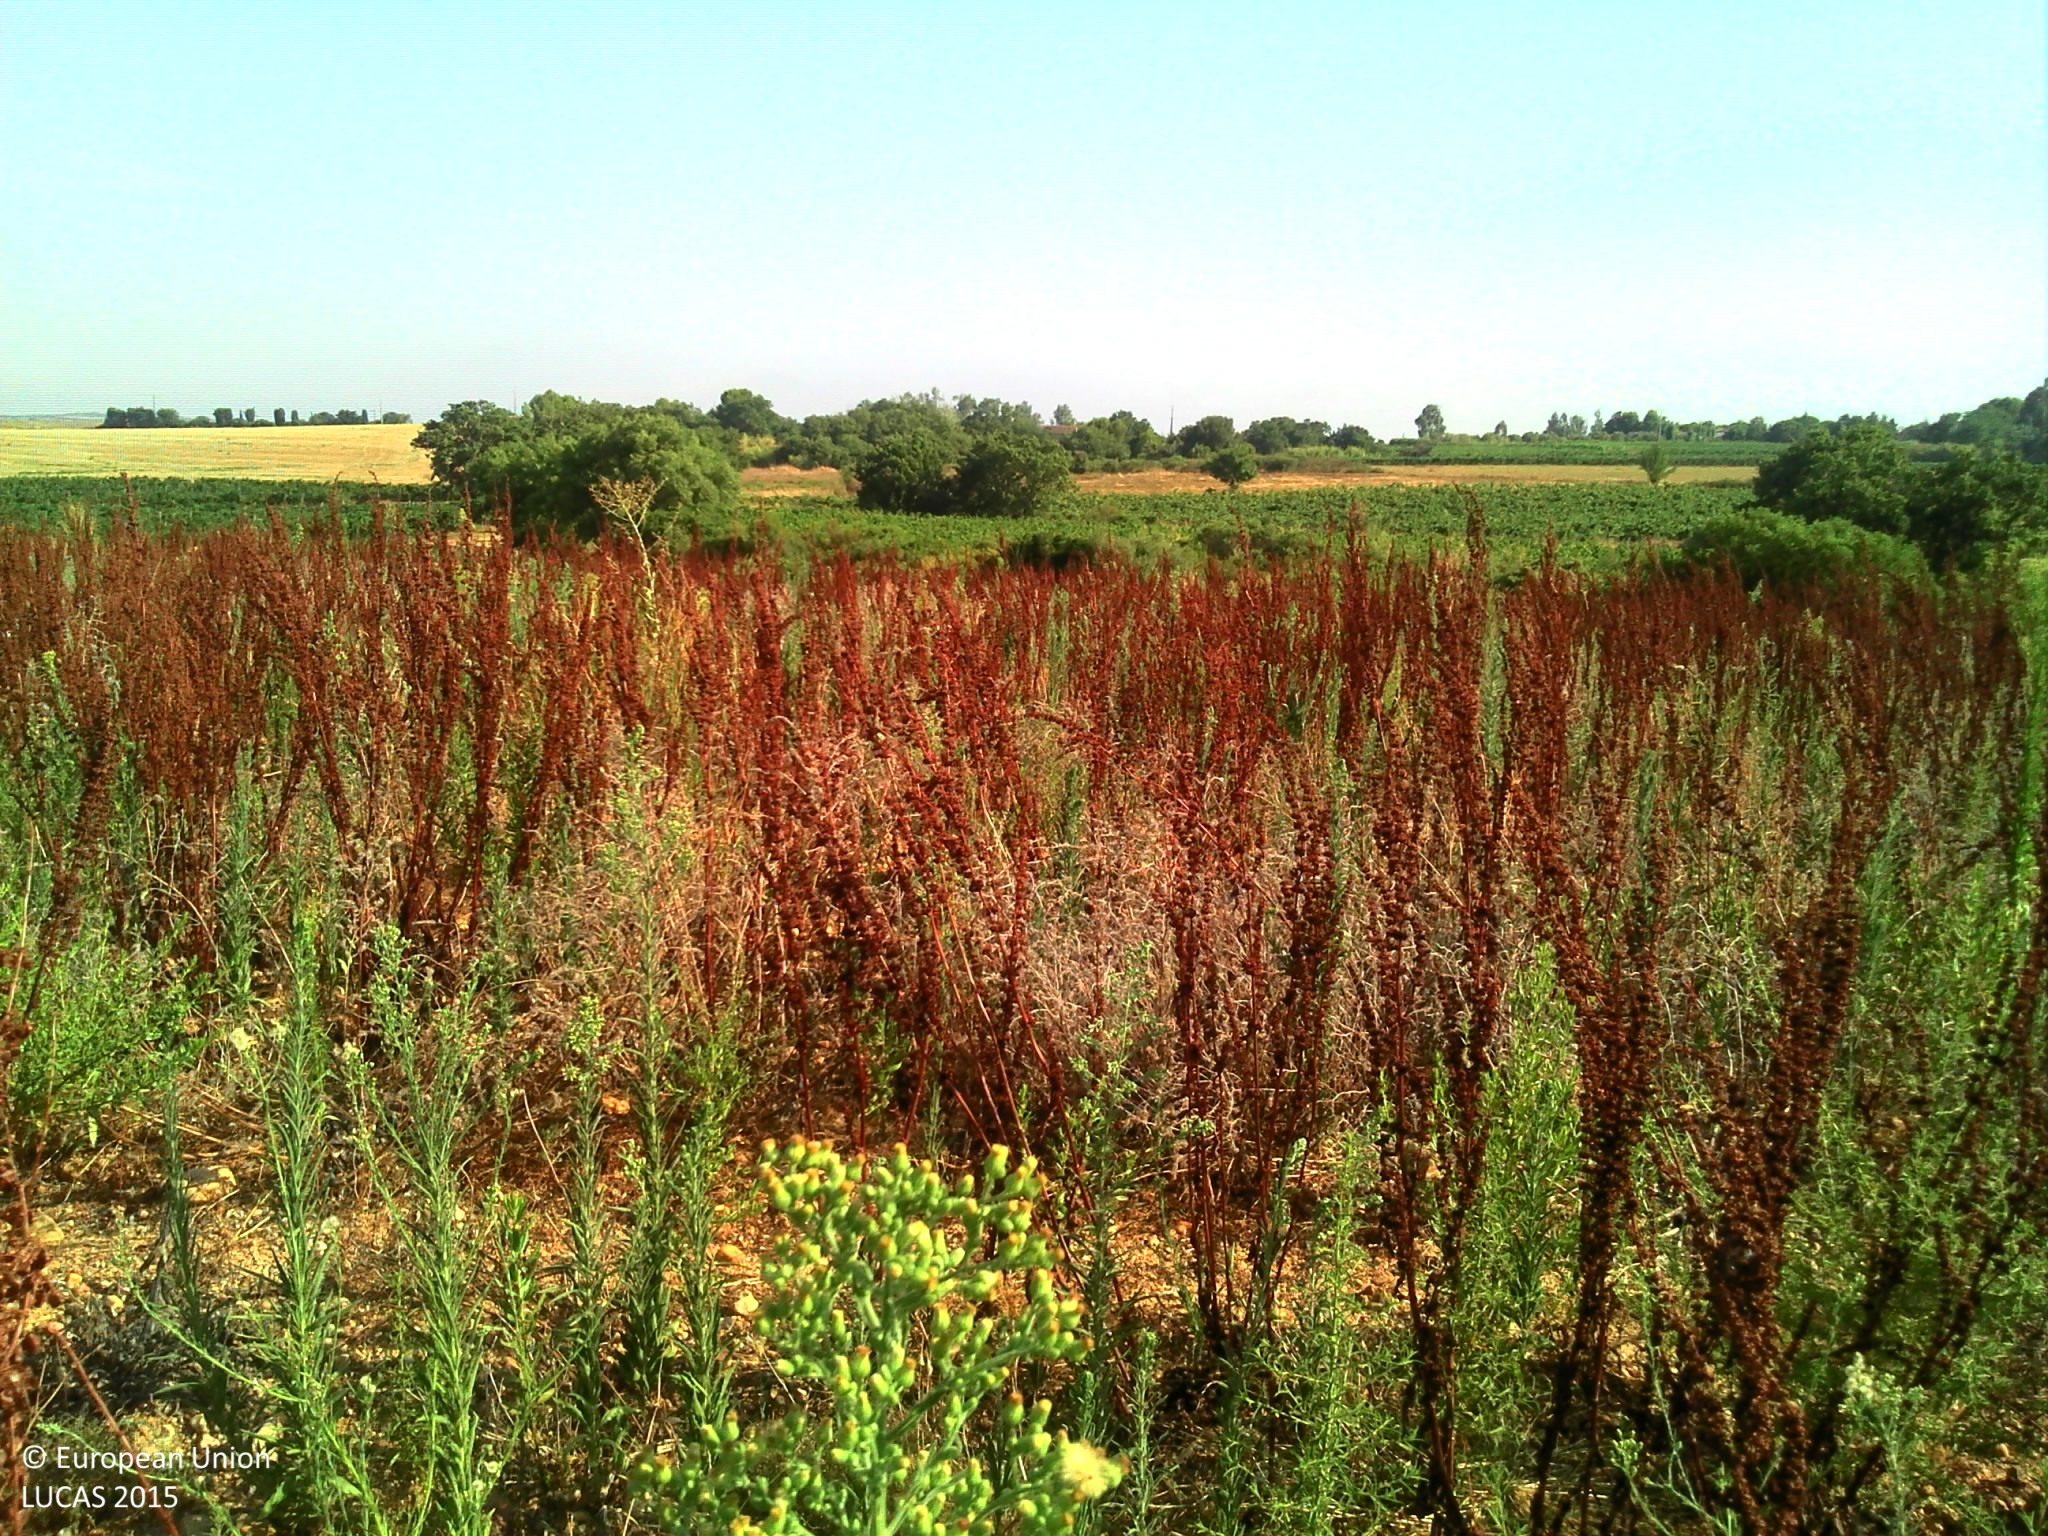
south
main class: Grassland
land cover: Spontaneously vegetated surfaces
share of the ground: > 75 %
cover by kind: herbaceous plants 95 %, unconsolidated bare surface 5 %
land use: Semi-natural and natural areas not in use
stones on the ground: > 50 %
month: August
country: FR
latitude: 43.3400
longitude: 3.3364
